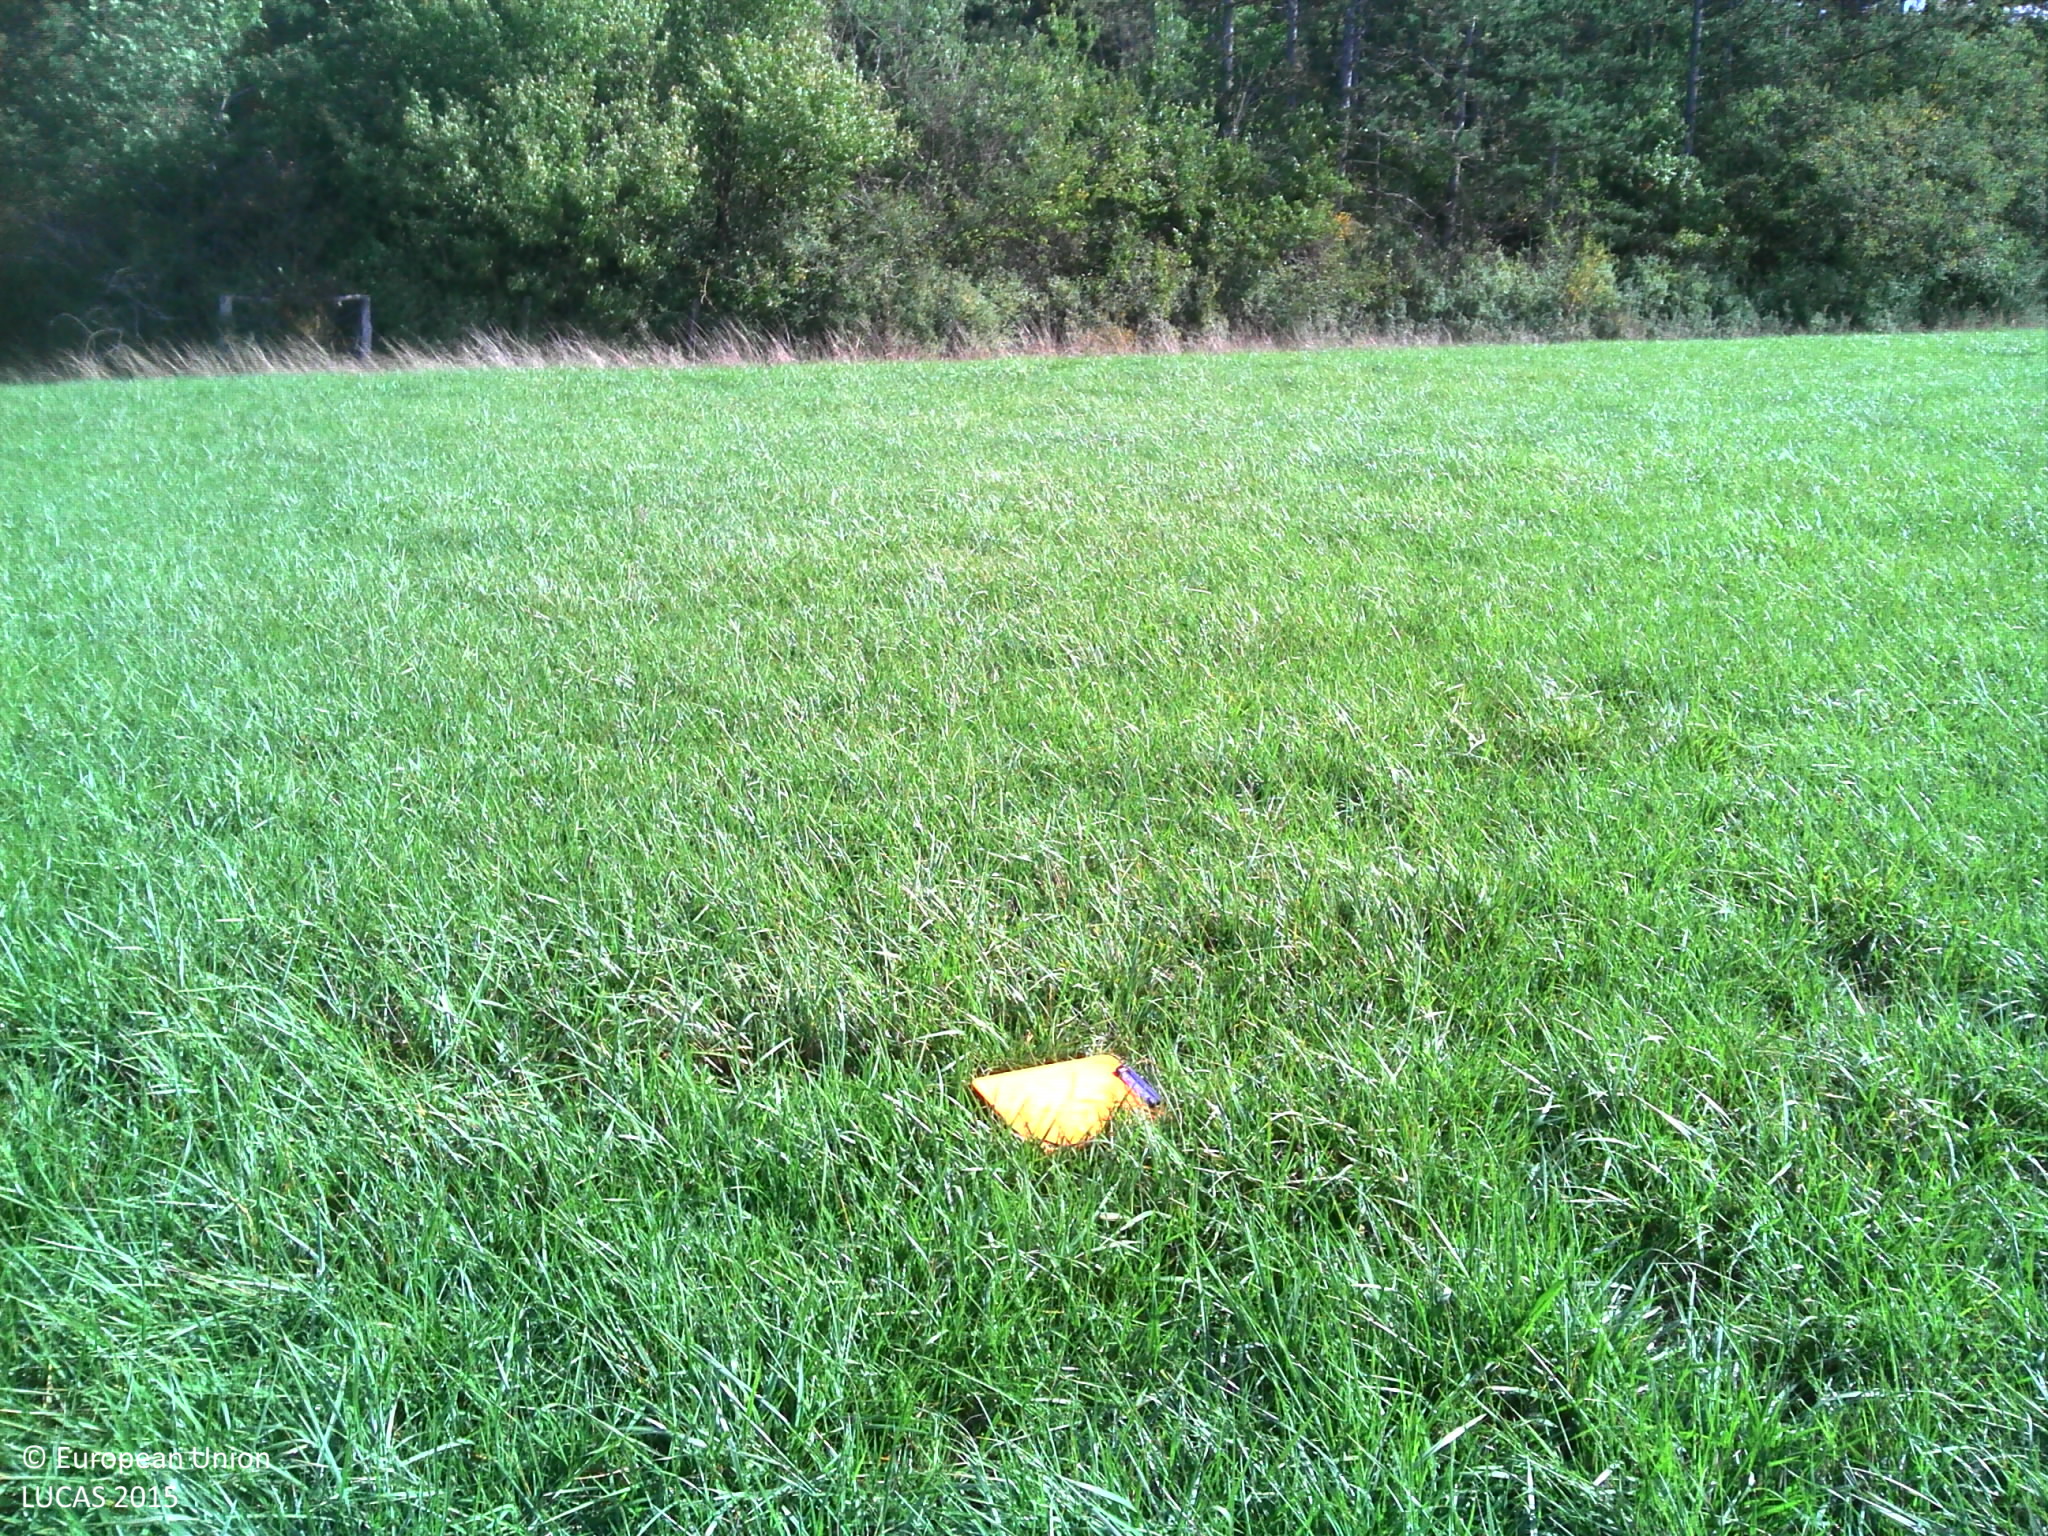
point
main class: Grassland
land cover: Grassland without tree/shrub cover
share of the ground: > 75 %
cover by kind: herbaceous plants 100 %
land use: Agriculture (excluding fallow land and kitchen gardens)
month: October
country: FR
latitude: 48.1889
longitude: 4.3881
